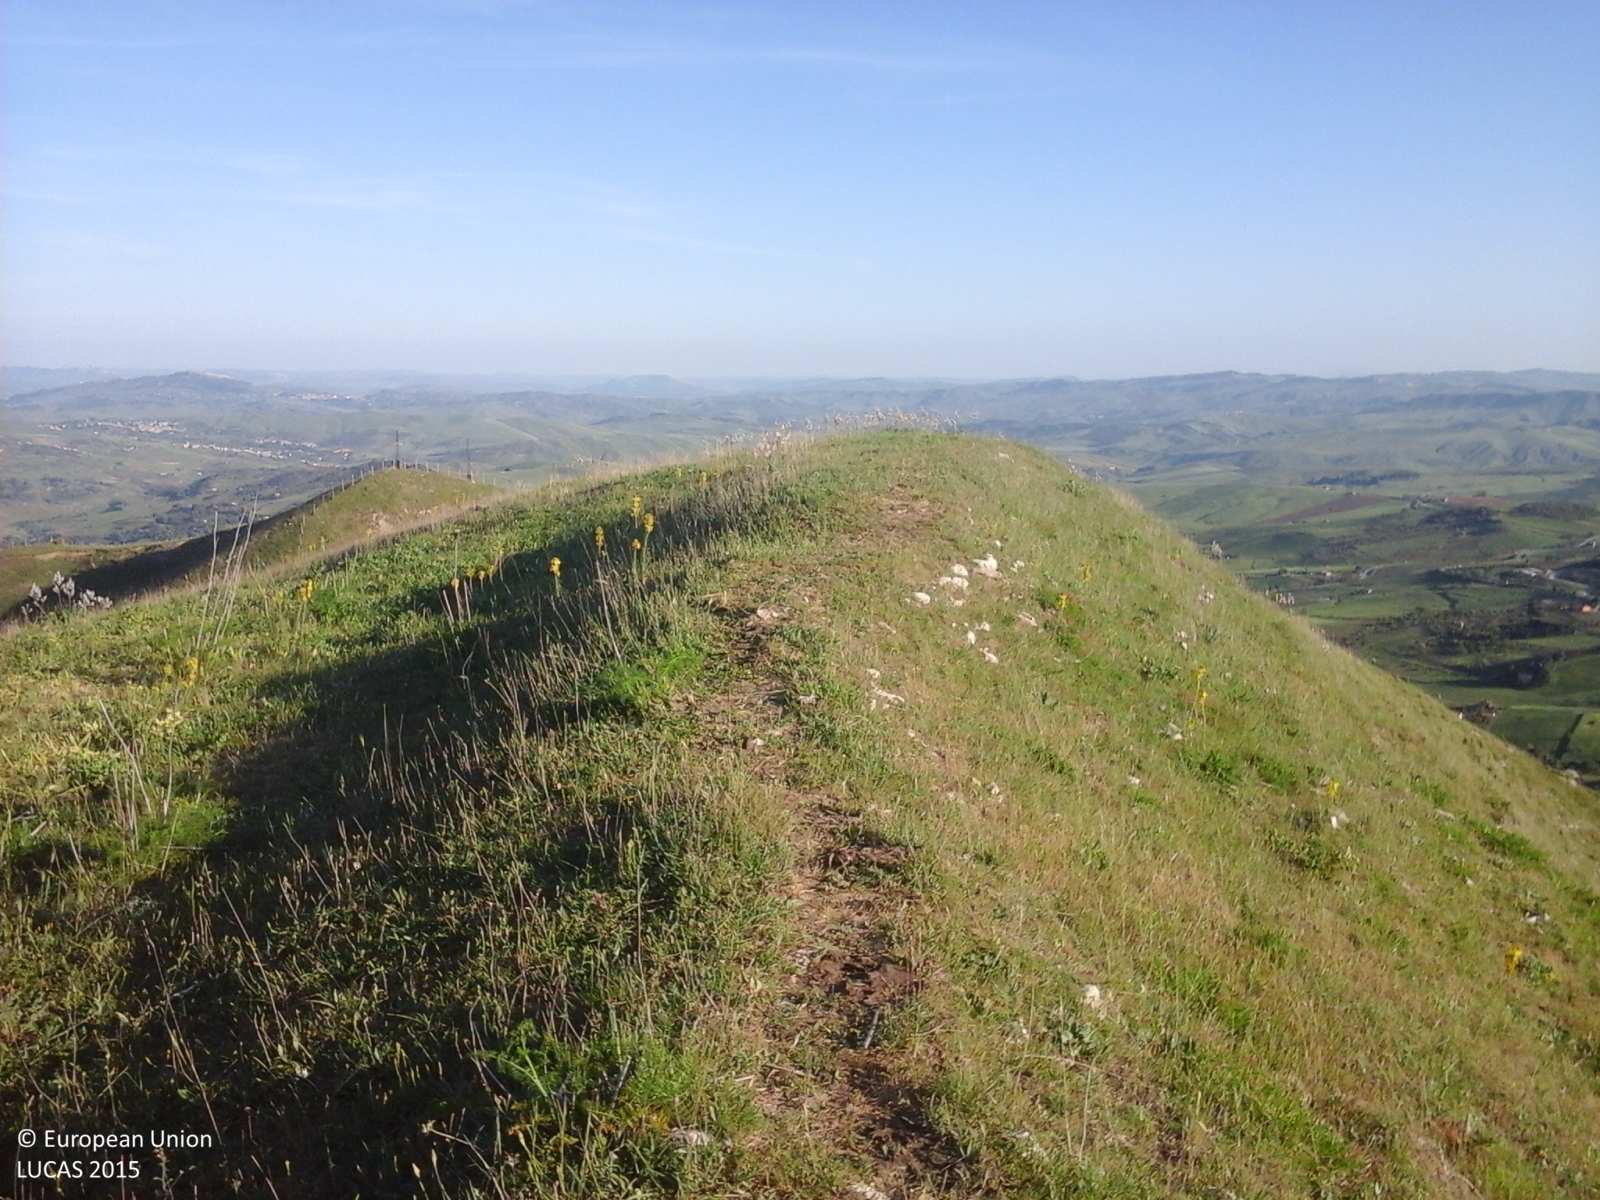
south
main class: Grassland
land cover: Grassland without tree/shrub cover
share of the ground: > 75 %
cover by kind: herbaceous plants 90 %, consolidated bare surface 5 %, unconsolidated bare surface 5 %
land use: Agriculture (excluding fallow land and kitchen gardens)
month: May
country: IT
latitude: 37.8077
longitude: 14.0261
